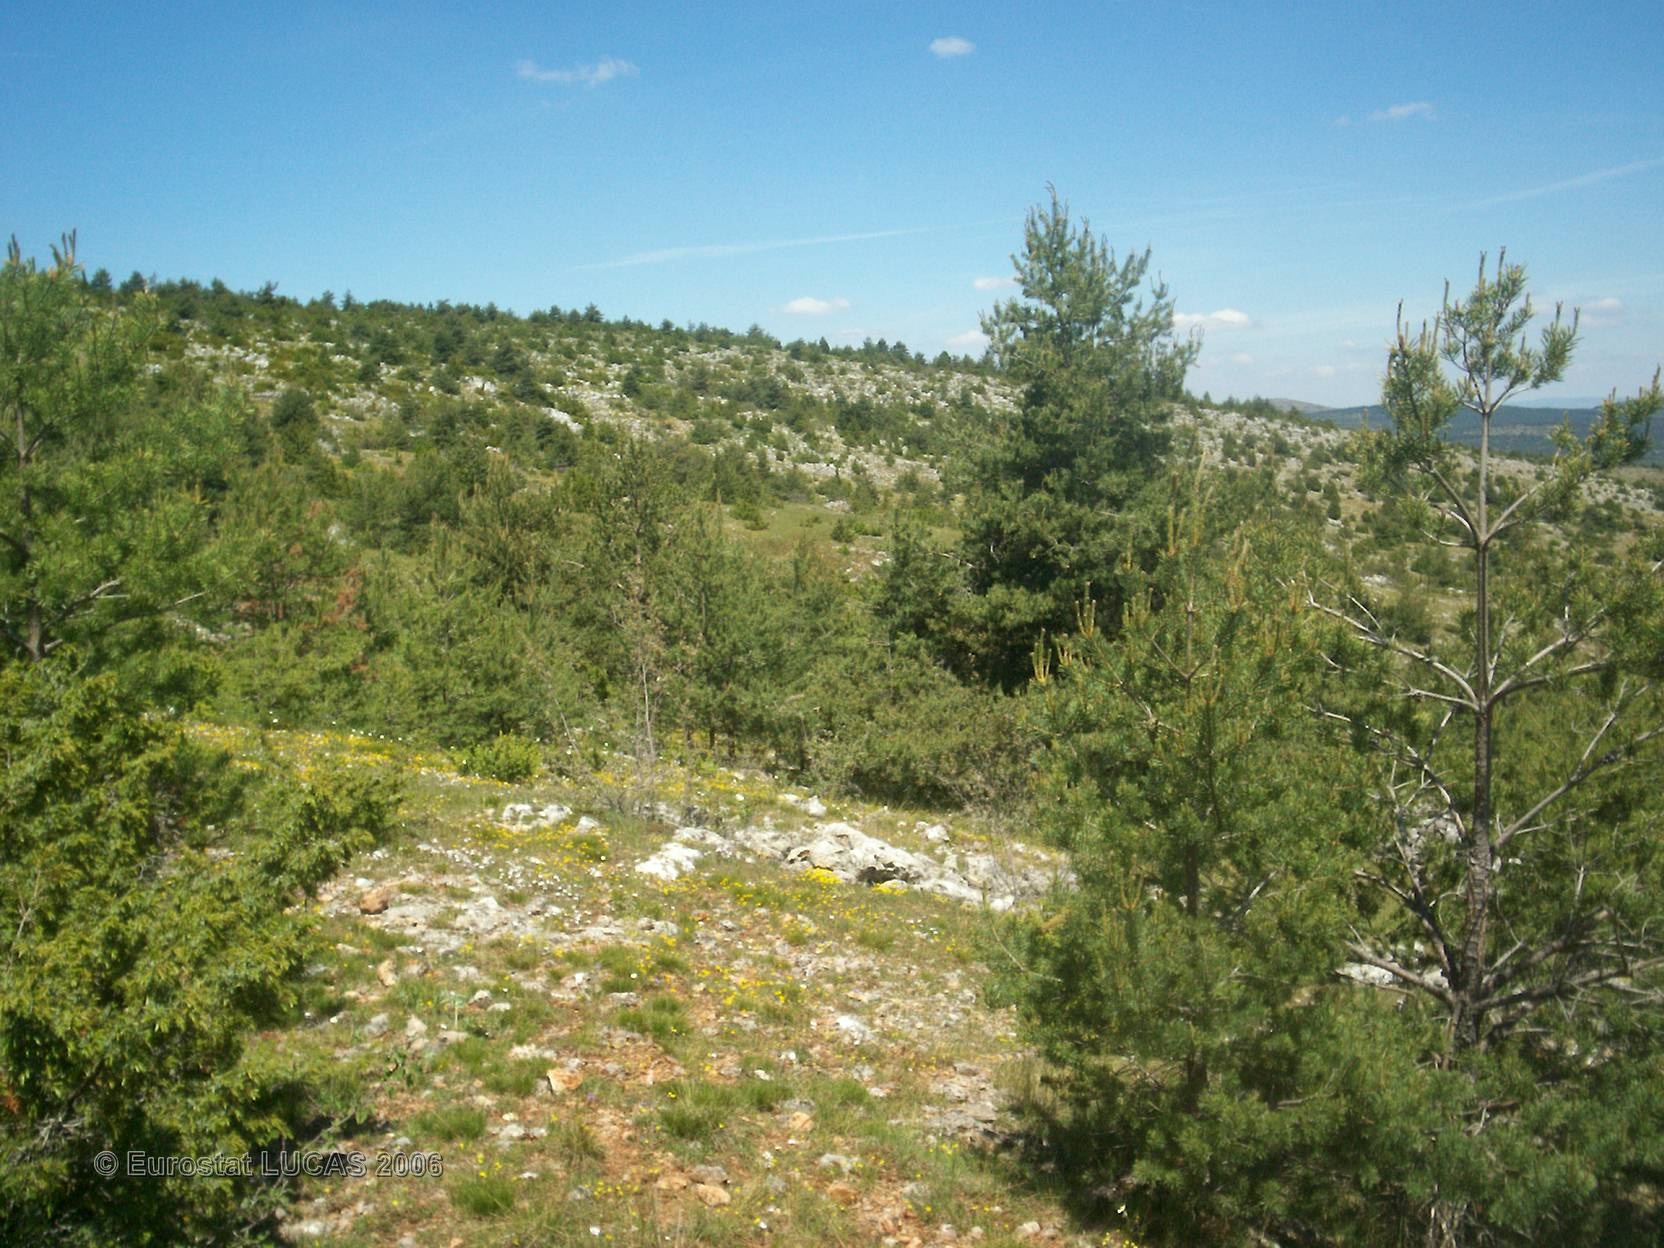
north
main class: Grassland
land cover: Grassland with sparse tree/shrub cover
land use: Agriculture (excluding fallow land and kitchen gardens)
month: June
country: FR
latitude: 44.2673
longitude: 3.4041
